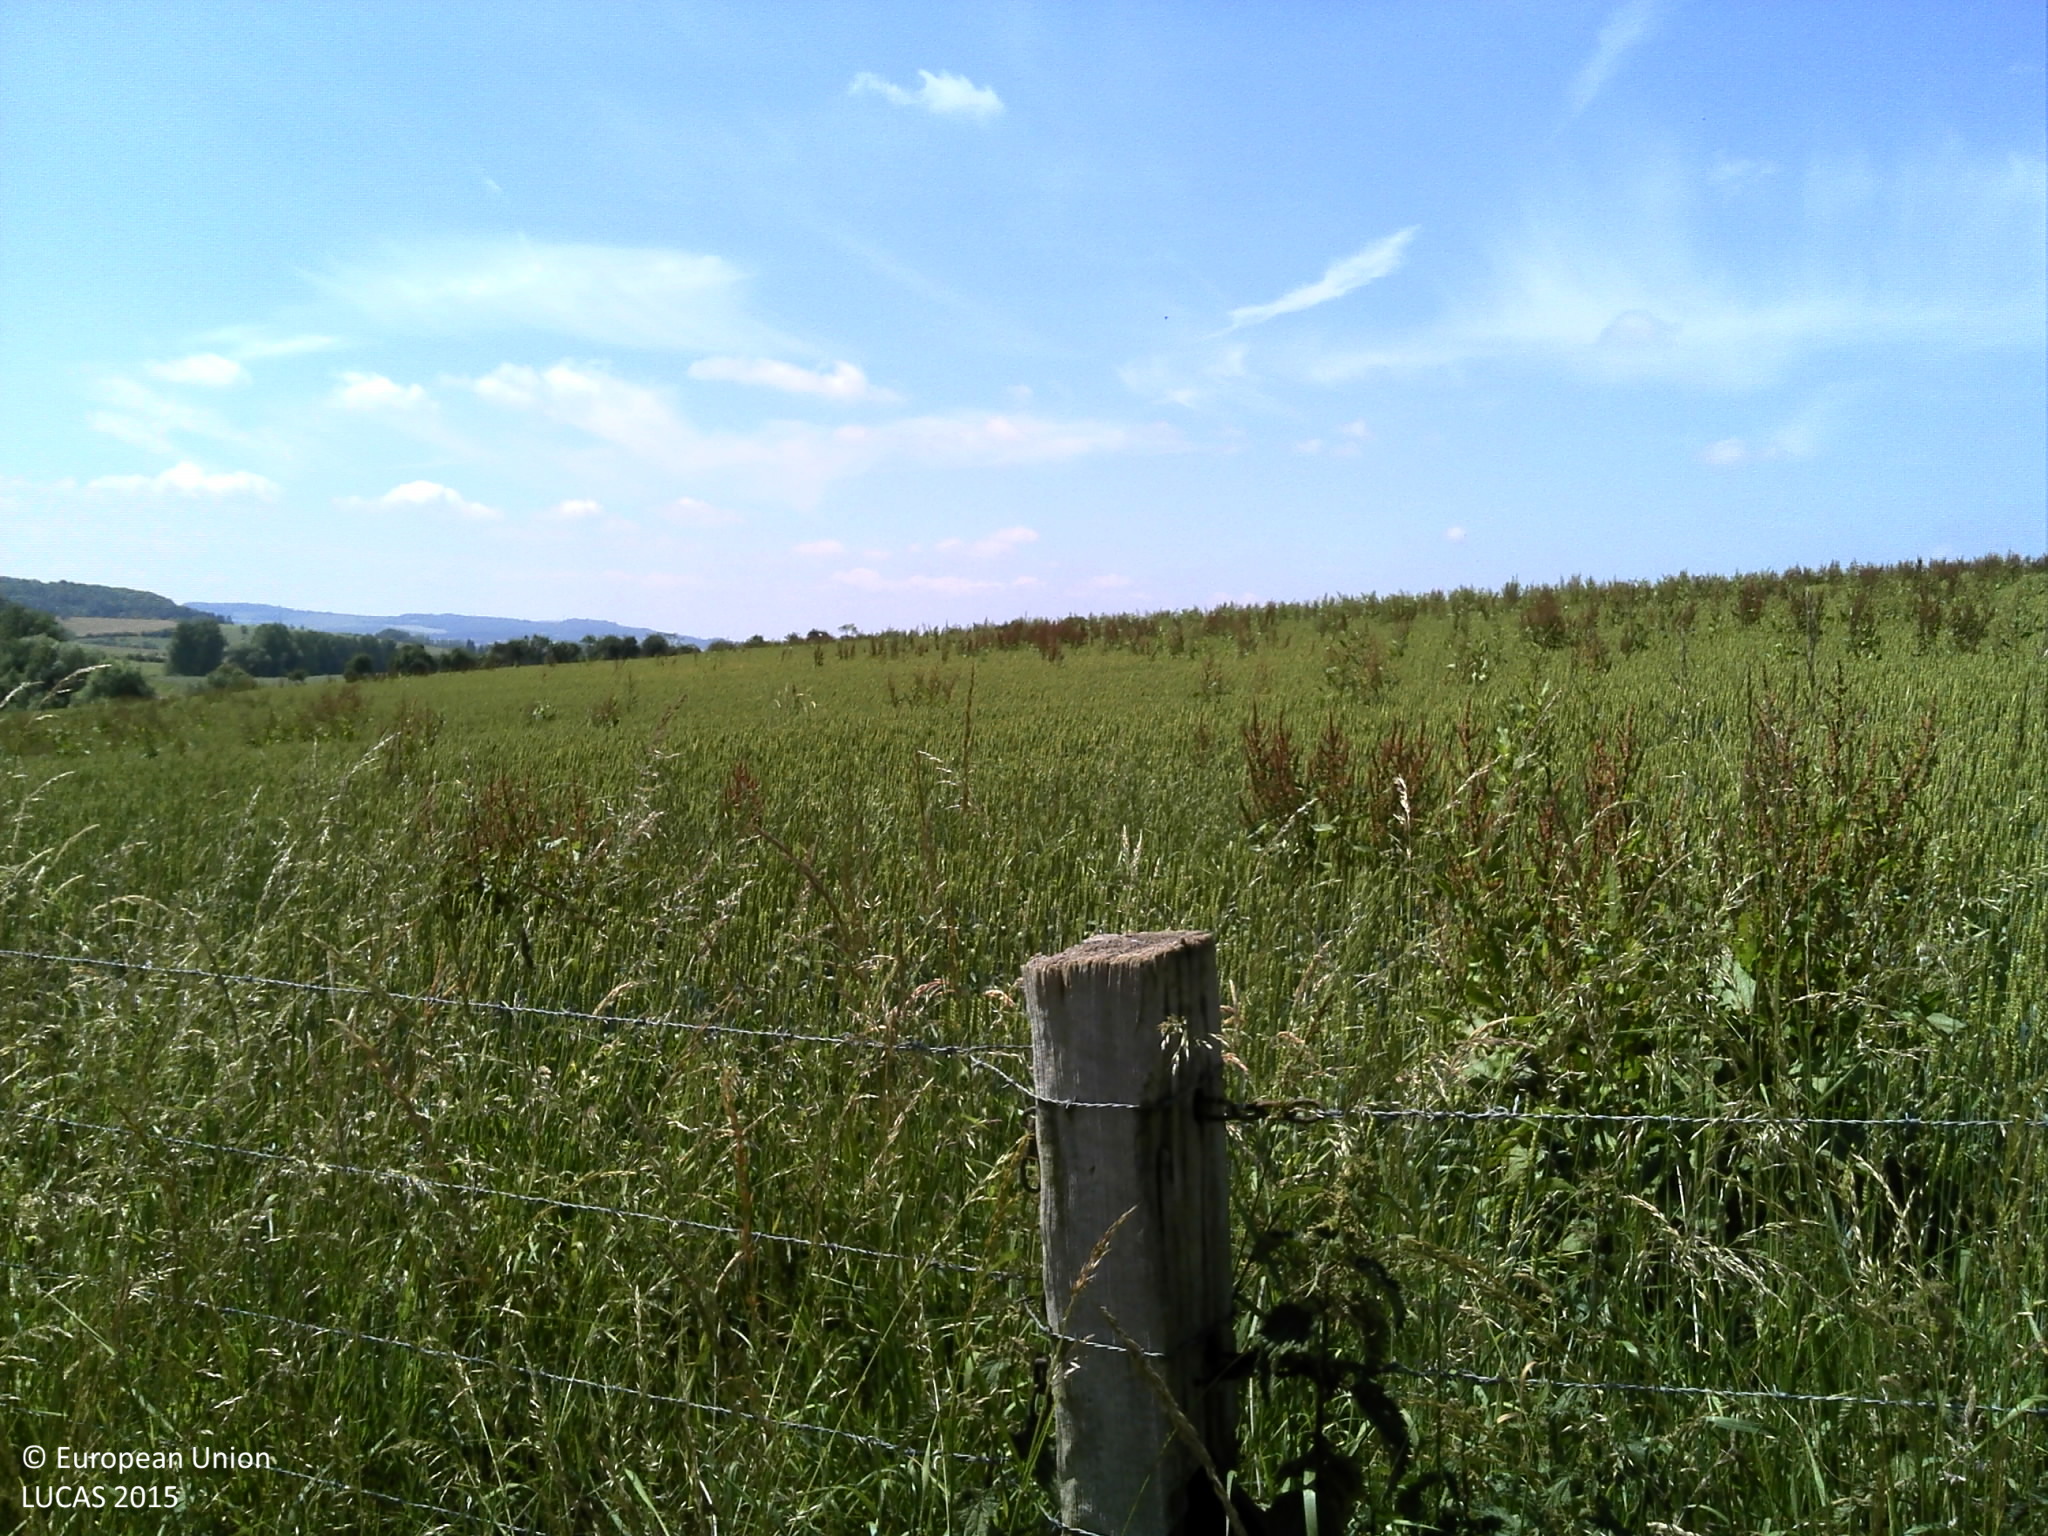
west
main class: Grassland
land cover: Grassland without tree/shrub cover
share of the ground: > 75 %
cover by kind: herbaceous plants 100 %
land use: Agriculture (excluding fallow land and kitchen gardens)
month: June
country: FR
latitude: 49.6517
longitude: 5.2193
